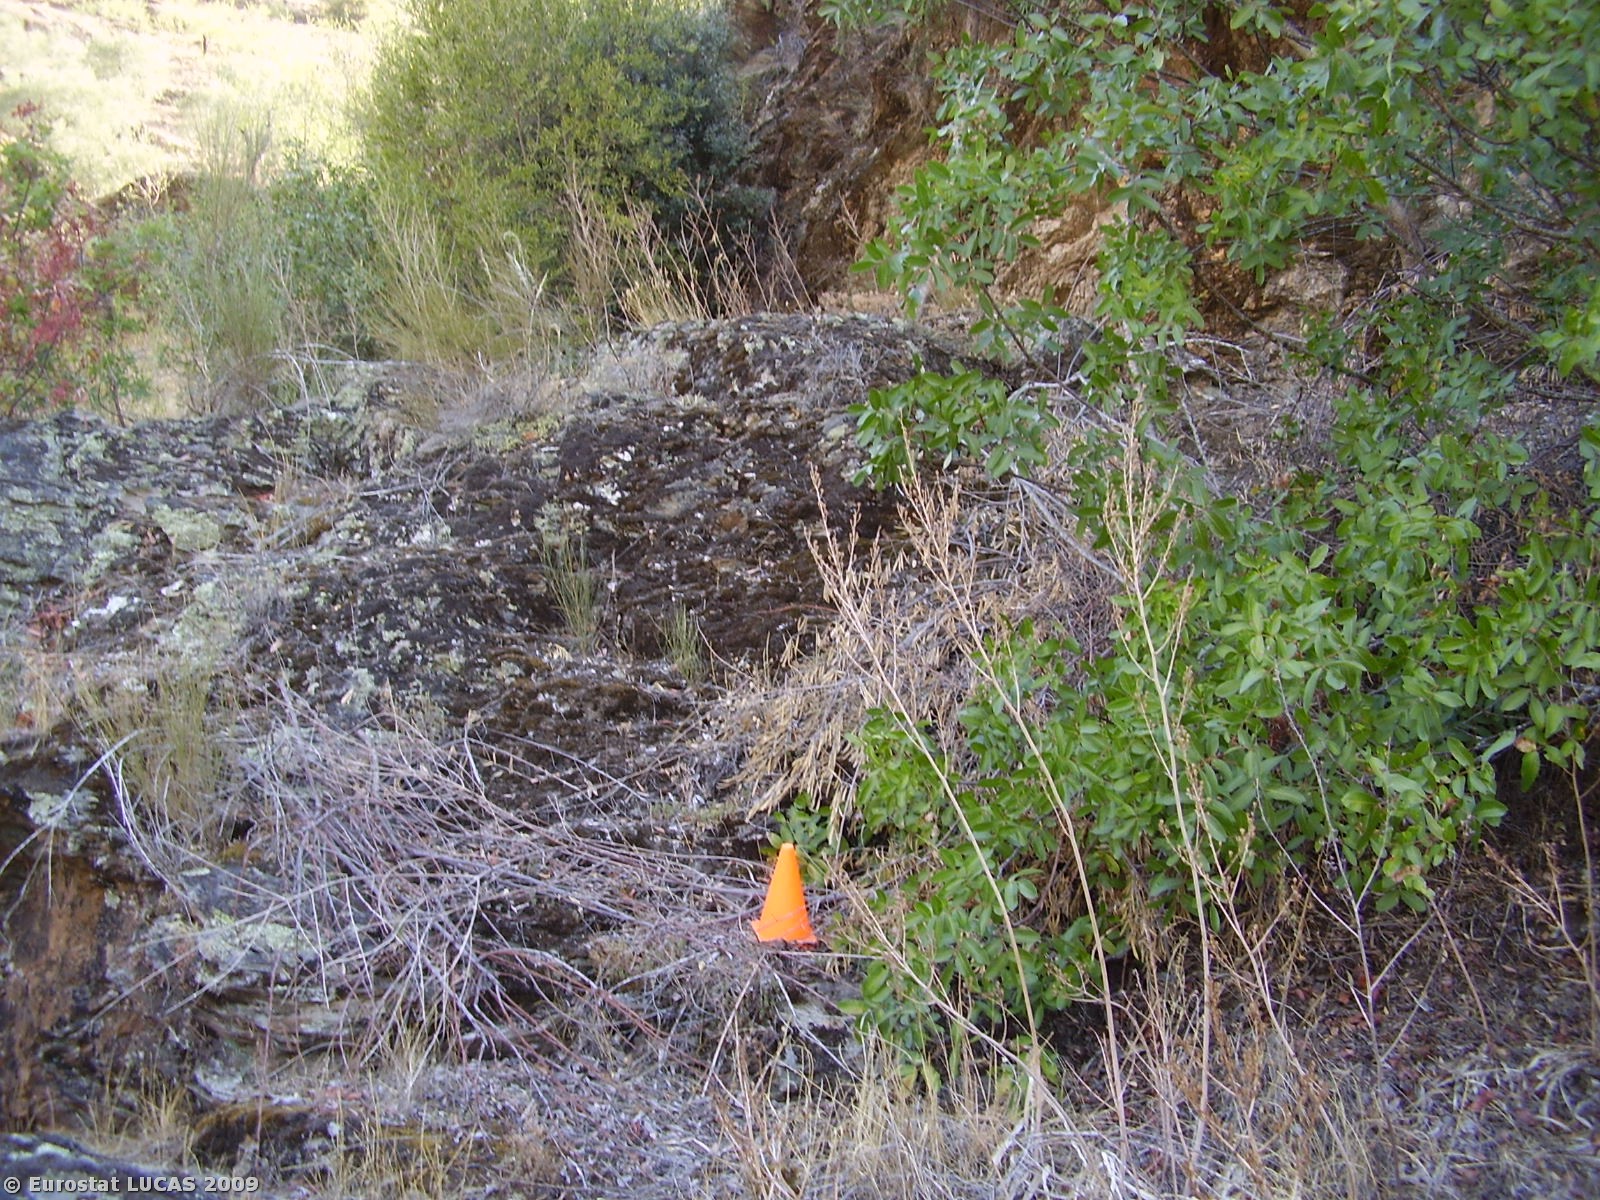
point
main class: Shrubland
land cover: Shrubland with sparse tree cover
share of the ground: > 75 %
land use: Fallow land
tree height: > 5 m
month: August
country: PT
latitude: 41.3271
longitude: -6.8226
